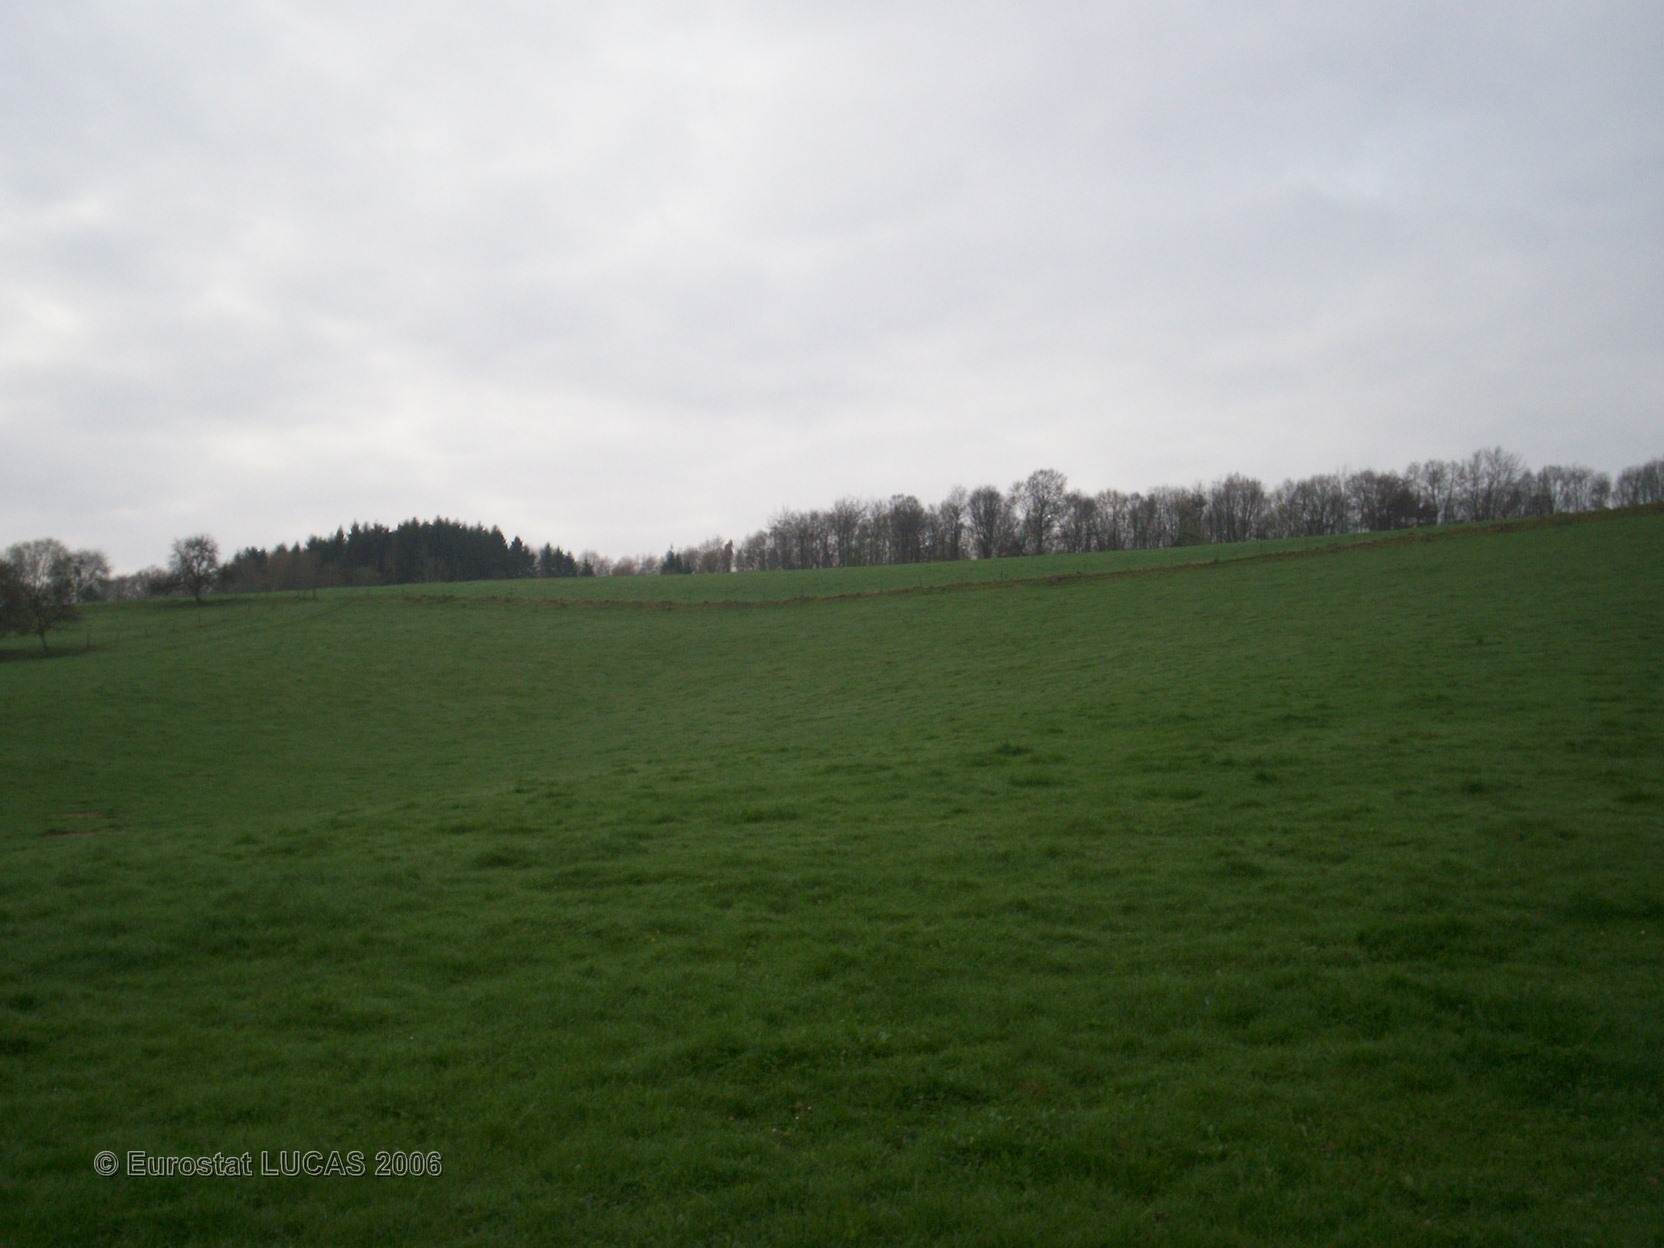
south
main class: Grassland
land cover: Grassland without tree/shrub cover
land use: Agriculture (excluding fallow land and kitchen gardens)
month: April
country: FR
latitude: 49.4361
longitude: 4.8259
